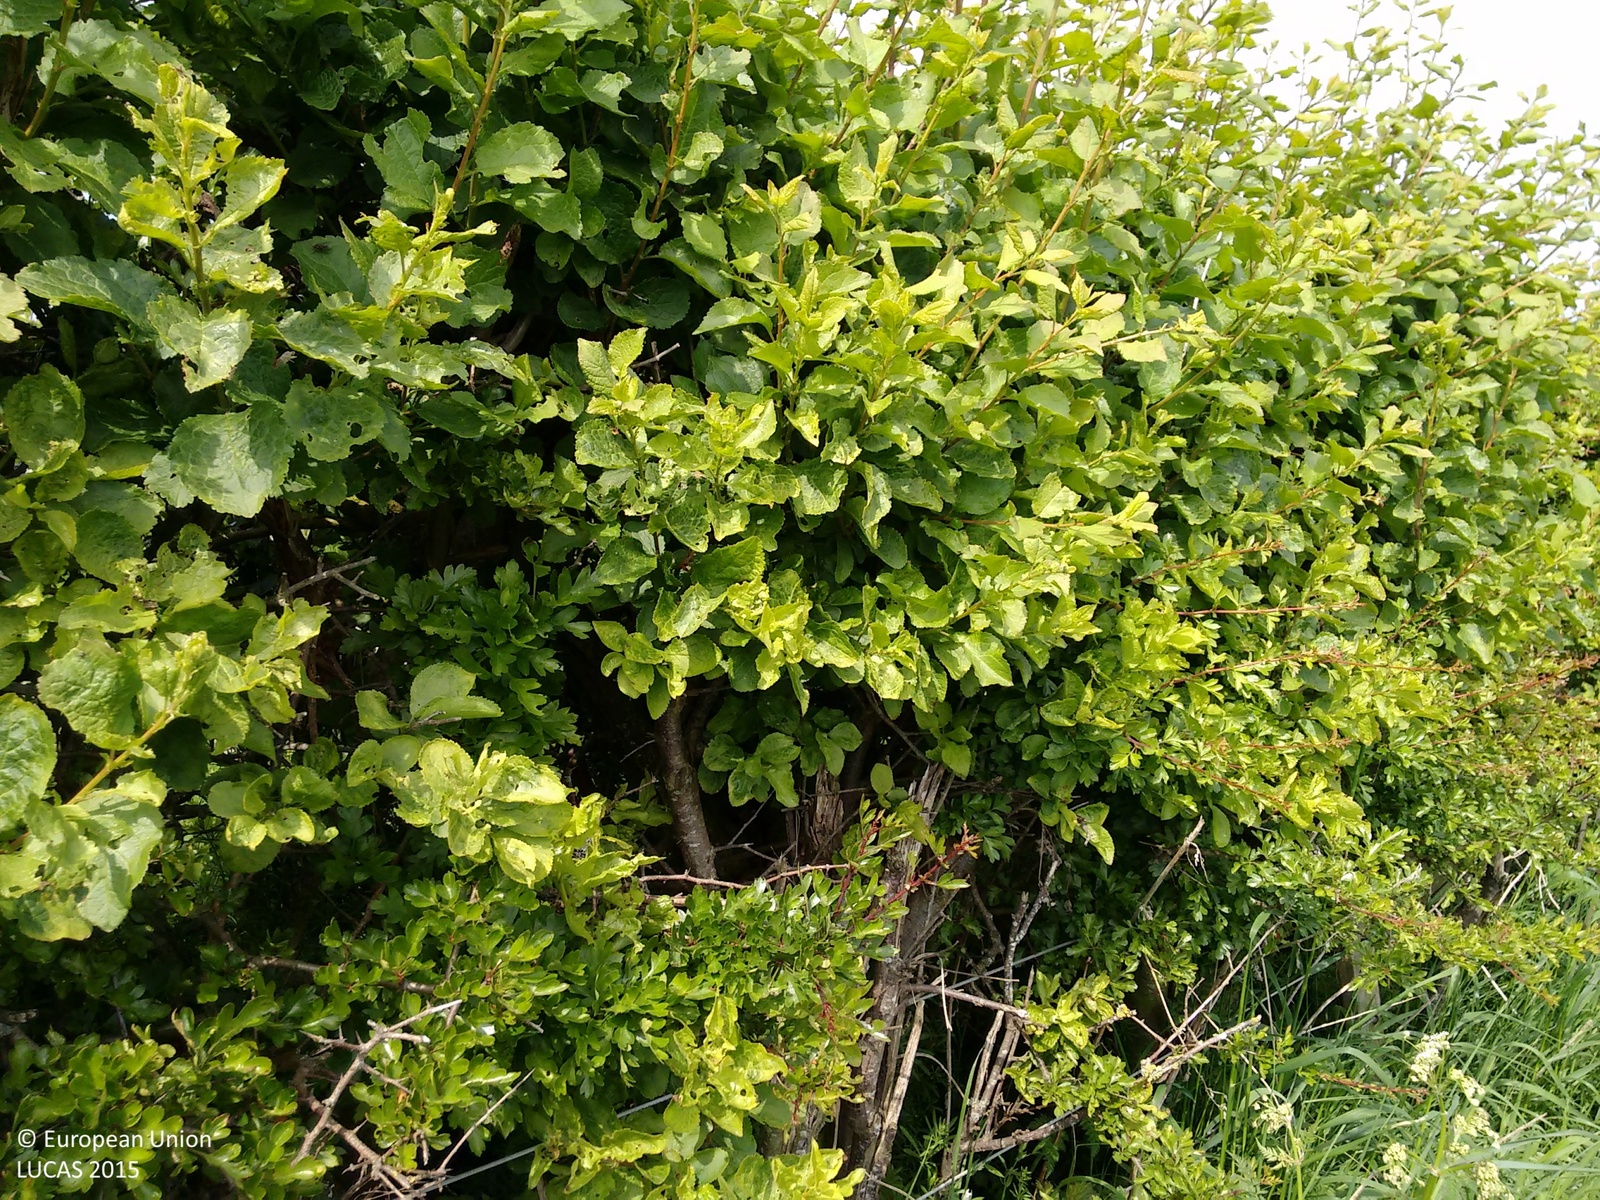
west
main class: Cropland
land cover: Barley
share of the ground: > 75 %
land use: Agriculture (excluding fallow land and kitchen gardens)
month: June
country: GB
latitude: 55.5358
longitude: -1.7589
